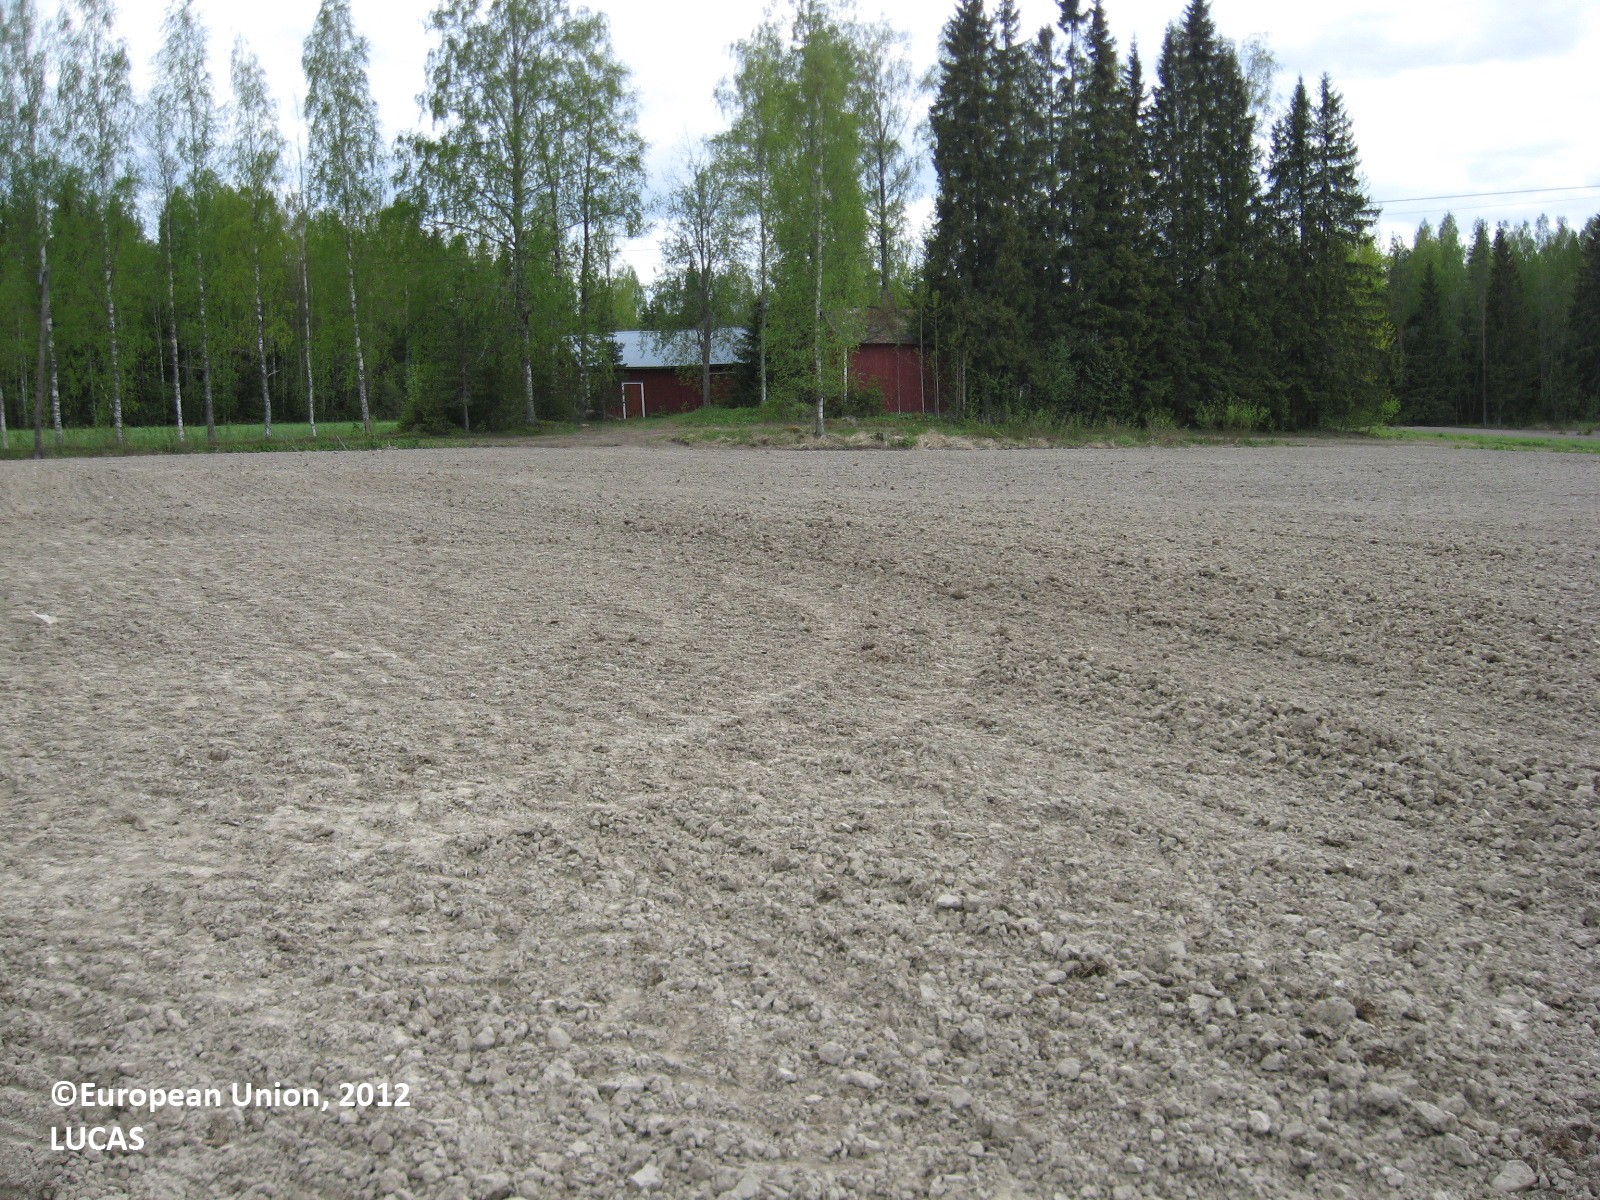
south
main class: Cropland
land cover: Oats
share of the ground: < 10 %
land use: Agriculture (excluding fallow land and kitchen gardens)
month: May
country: FI
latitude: 61.8267
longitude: 22.5739
